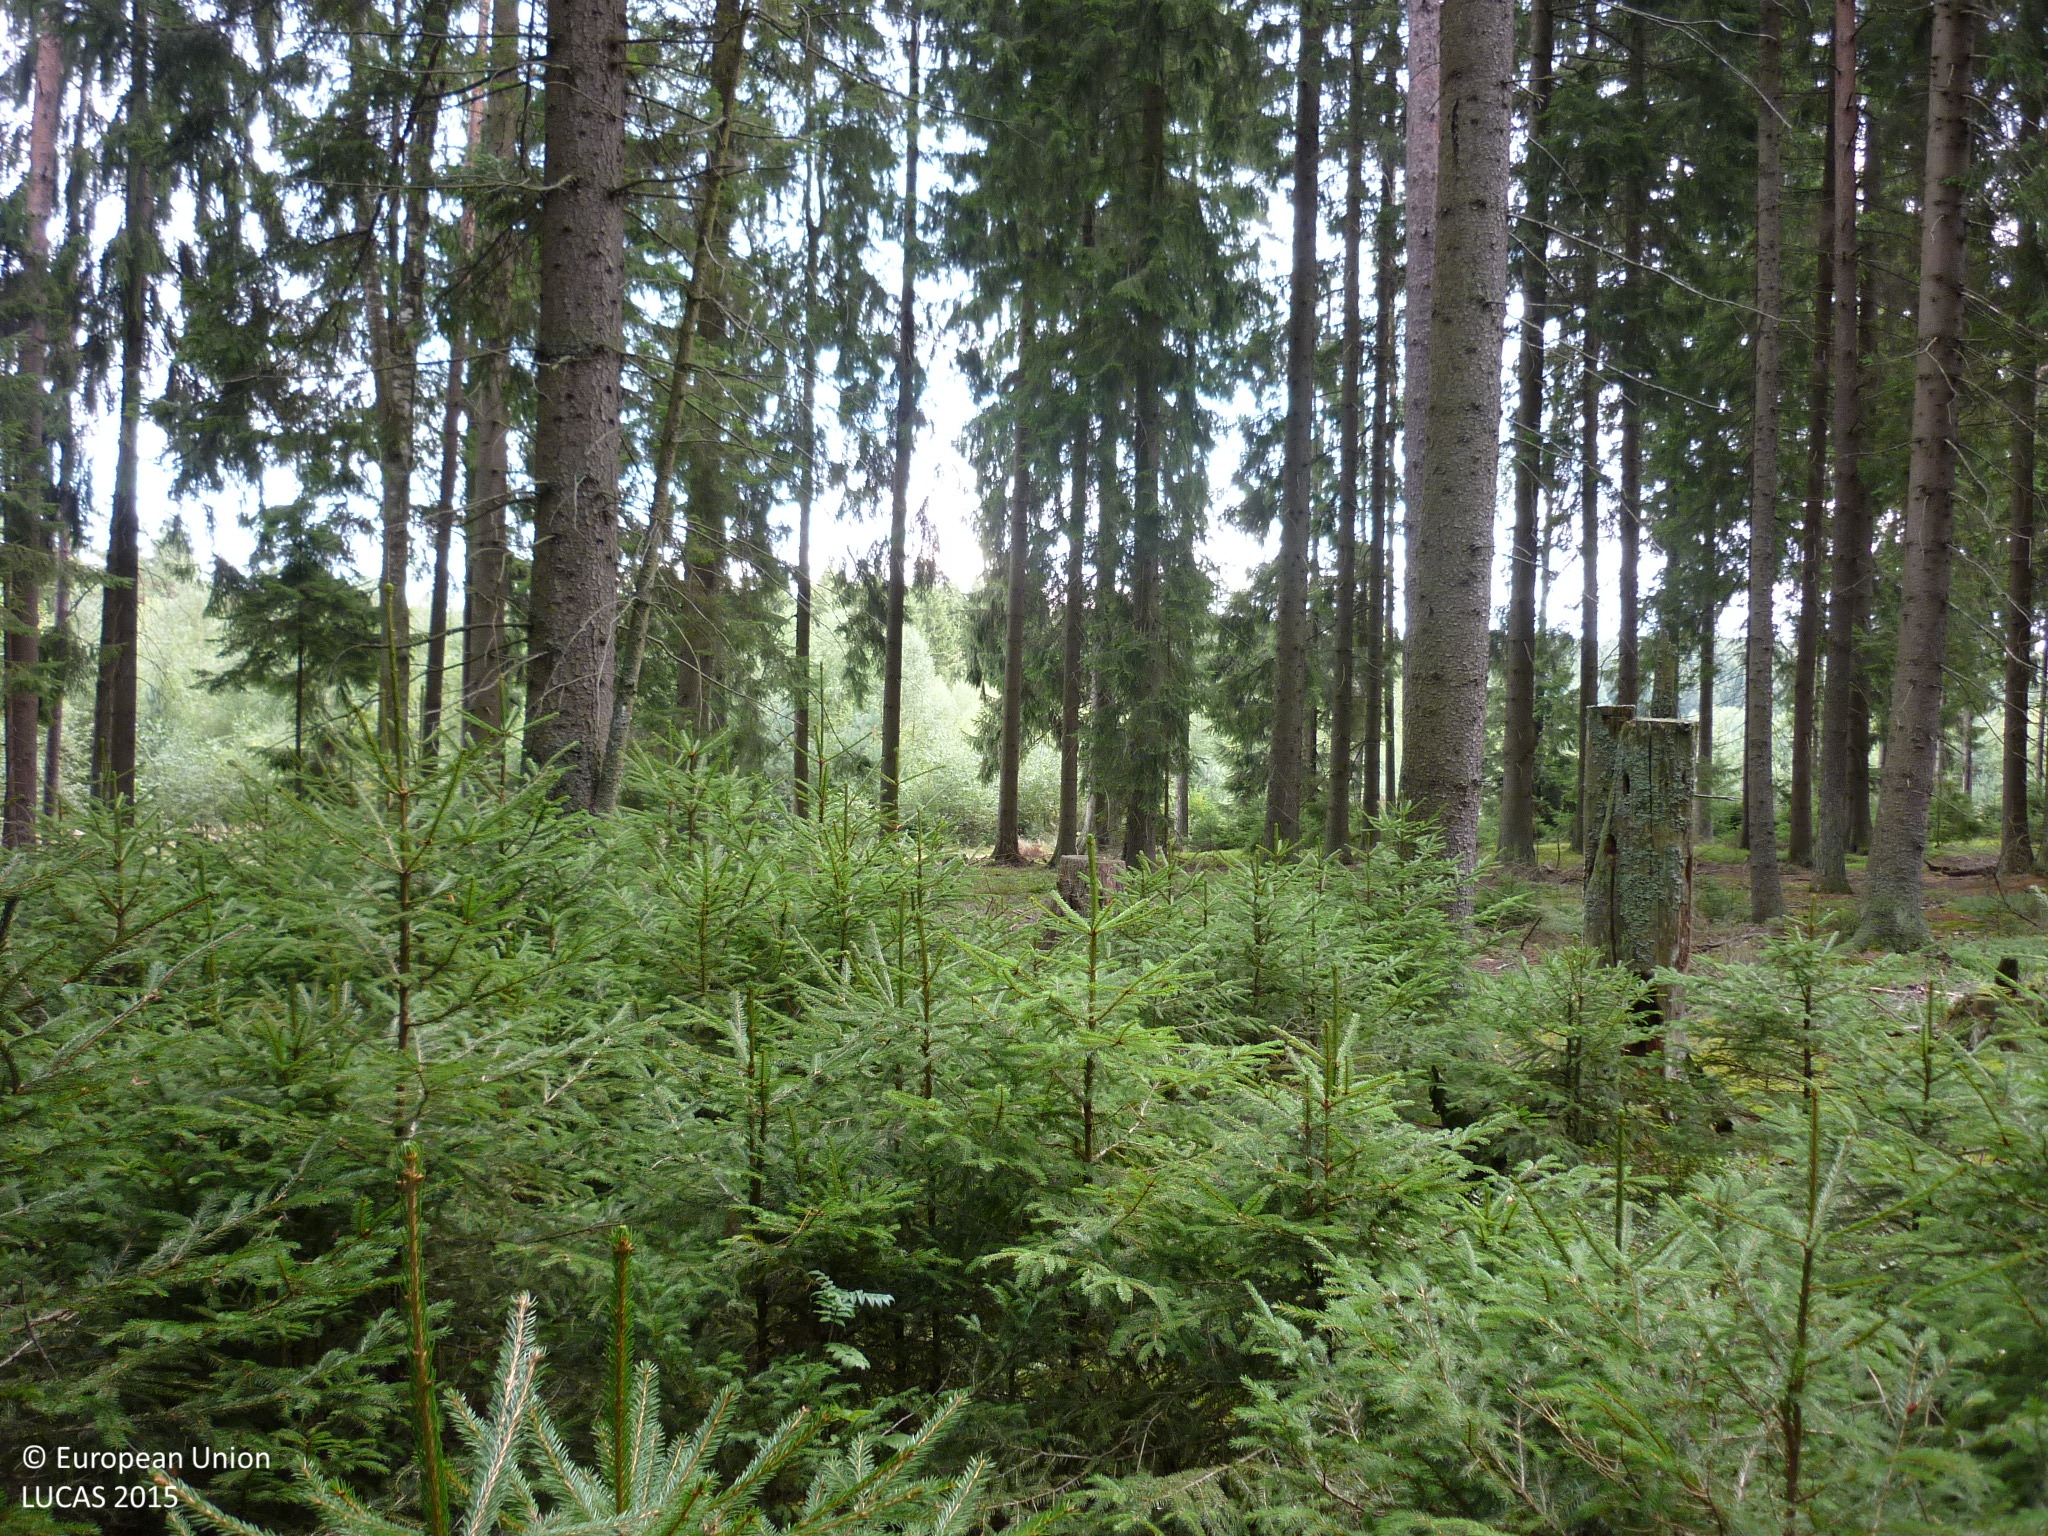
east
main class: Woodland
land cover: Spruce dominated coniferous woodland
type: hemiboreal forest and nemoral coniferous forest and mixed broadleaved-coniferous forest
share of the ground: > 75 %
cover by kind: coniferous forest trees 95 %, shrubs 5 %
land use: Forestry
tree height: > 5 m
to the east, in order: Spruce dominated coniferous woodland; Tracks; Pine dominated mixed woodland; Spruce dominated coniferous woodland; Broadleaved woodland; Tracks; Abandoned hedges; Inland fresh water bodies
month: September
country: AT
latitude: 48.9351
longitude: 15.0941
